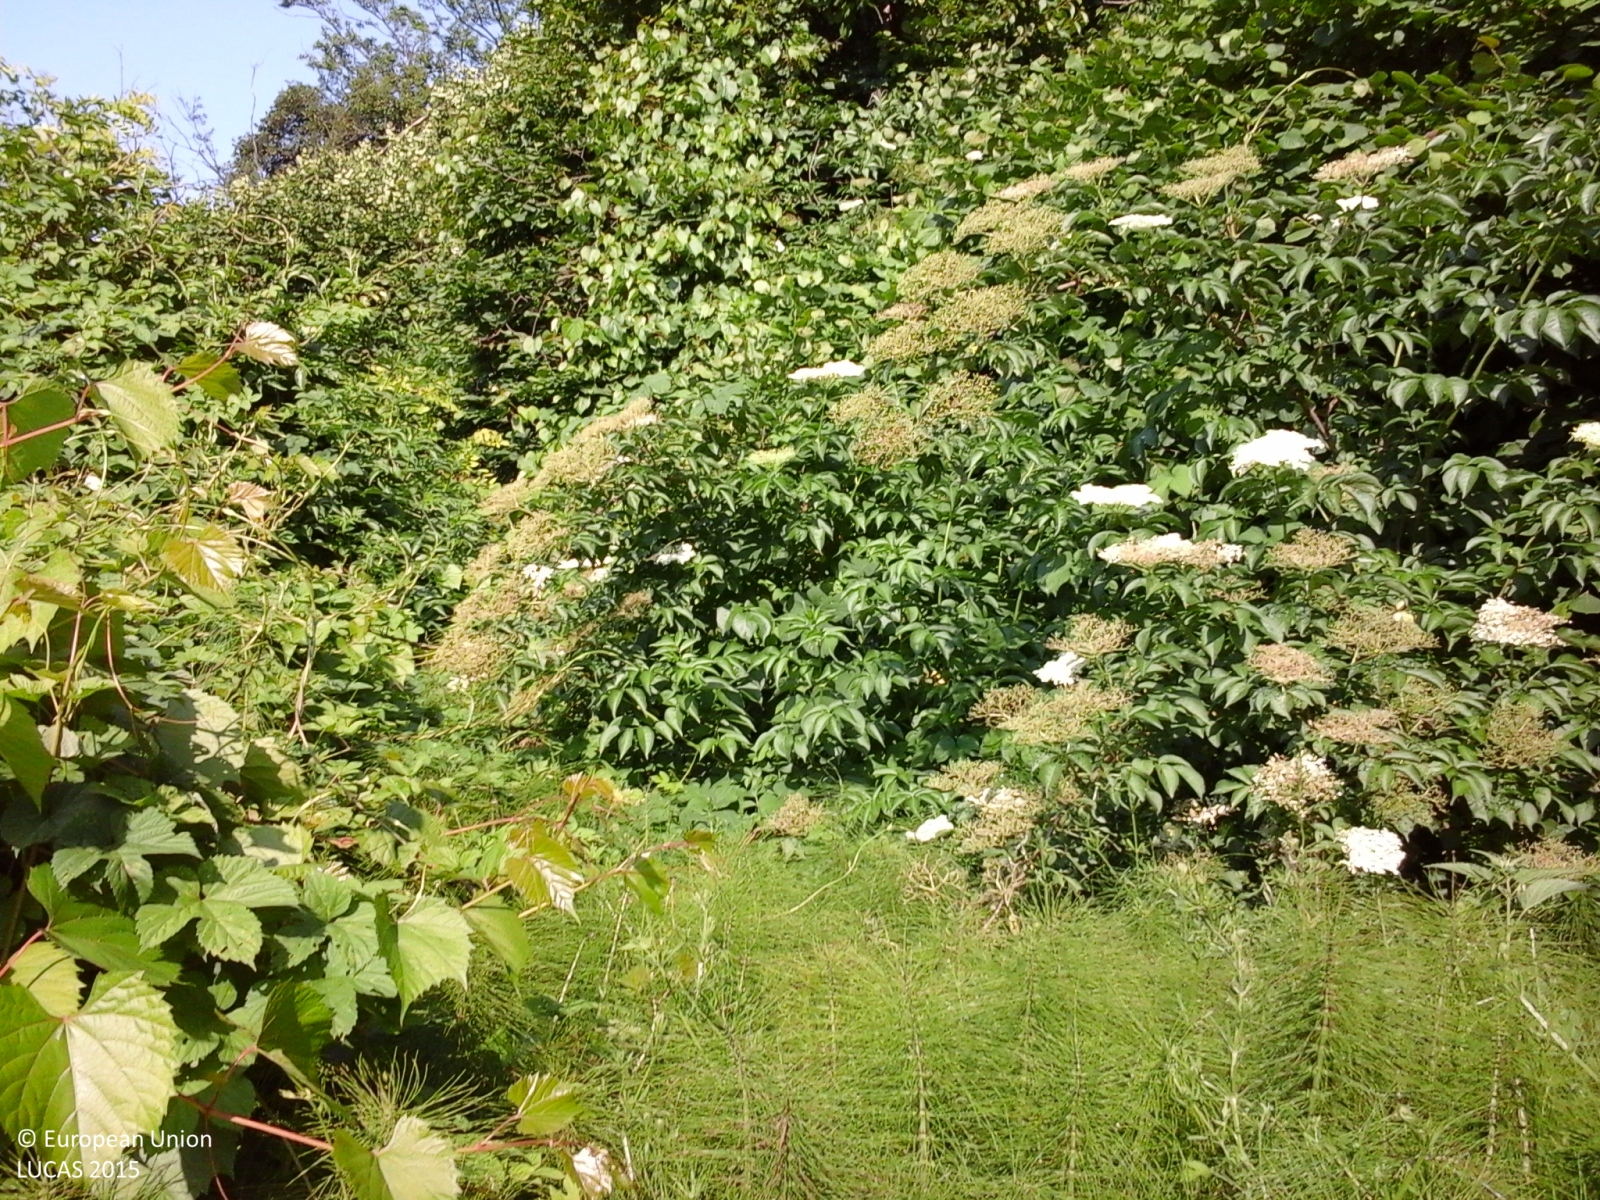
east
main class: Woodland
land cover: Broadleaved woodland
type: mesophytic deciduous forest
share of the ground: > 75 %
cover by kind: broadleaved forest trees 95 %, shrubs 5 %
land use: Forestry
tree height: > 5 m
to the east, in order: Broadleaved woodland
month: May
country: IT
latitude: 44.7711
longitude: 8.3985
